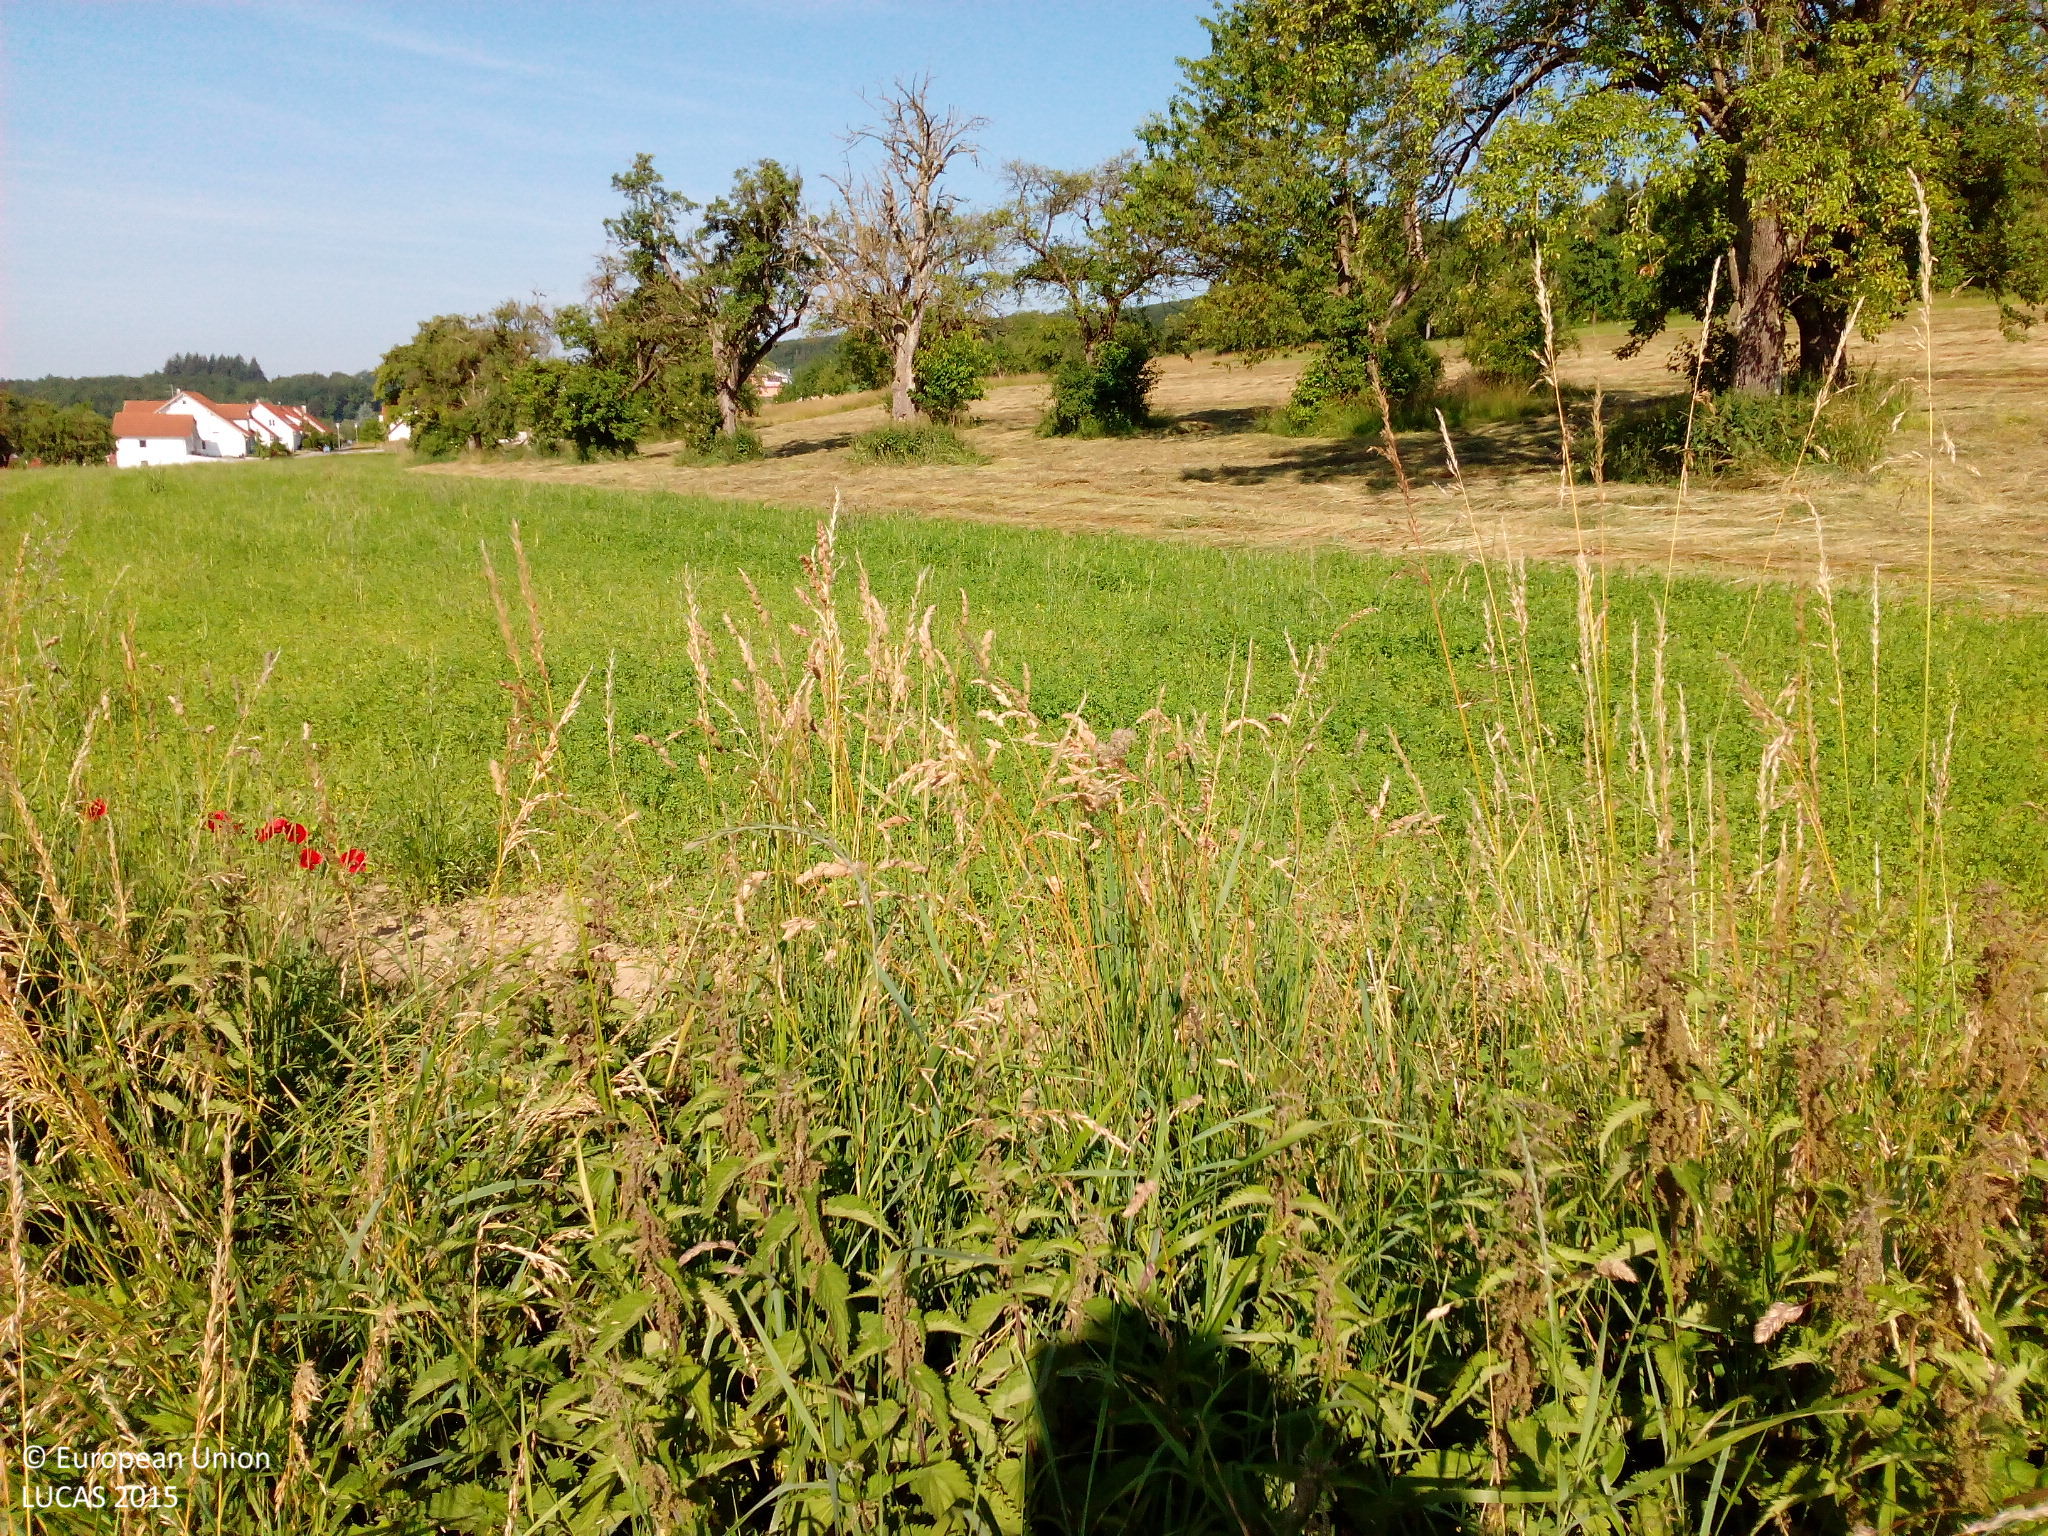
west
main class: Cropland
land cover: Lucerne
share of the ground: > 75 %
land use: Agriculture (excluding fallow land and kitchen gardens)
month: June
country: DE
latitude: 48.2769
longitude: 9.6364
